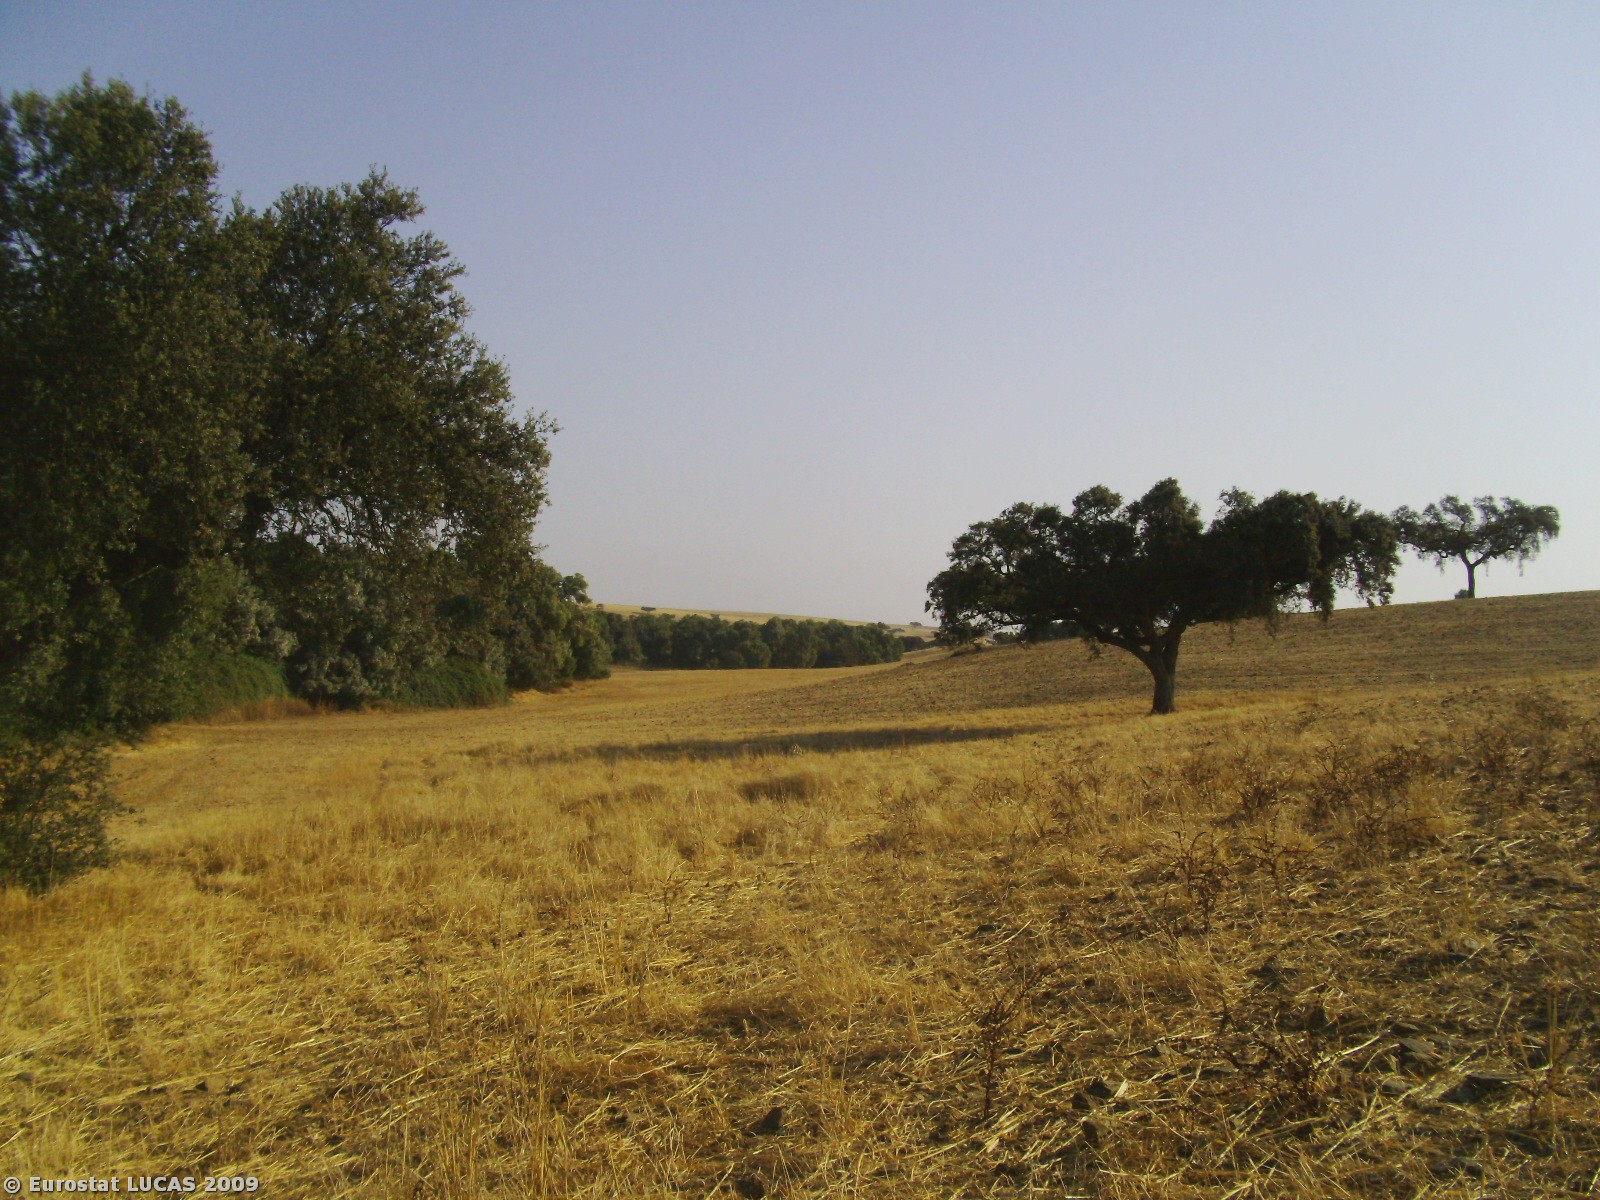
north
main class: Grassland
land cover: Grassland without tree/shrub cover
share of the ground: > 75 %
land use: Agriculture (excluding fallow land and kitchen gardens)
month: August
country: PT
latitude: 38.4032
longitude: -7.7003
